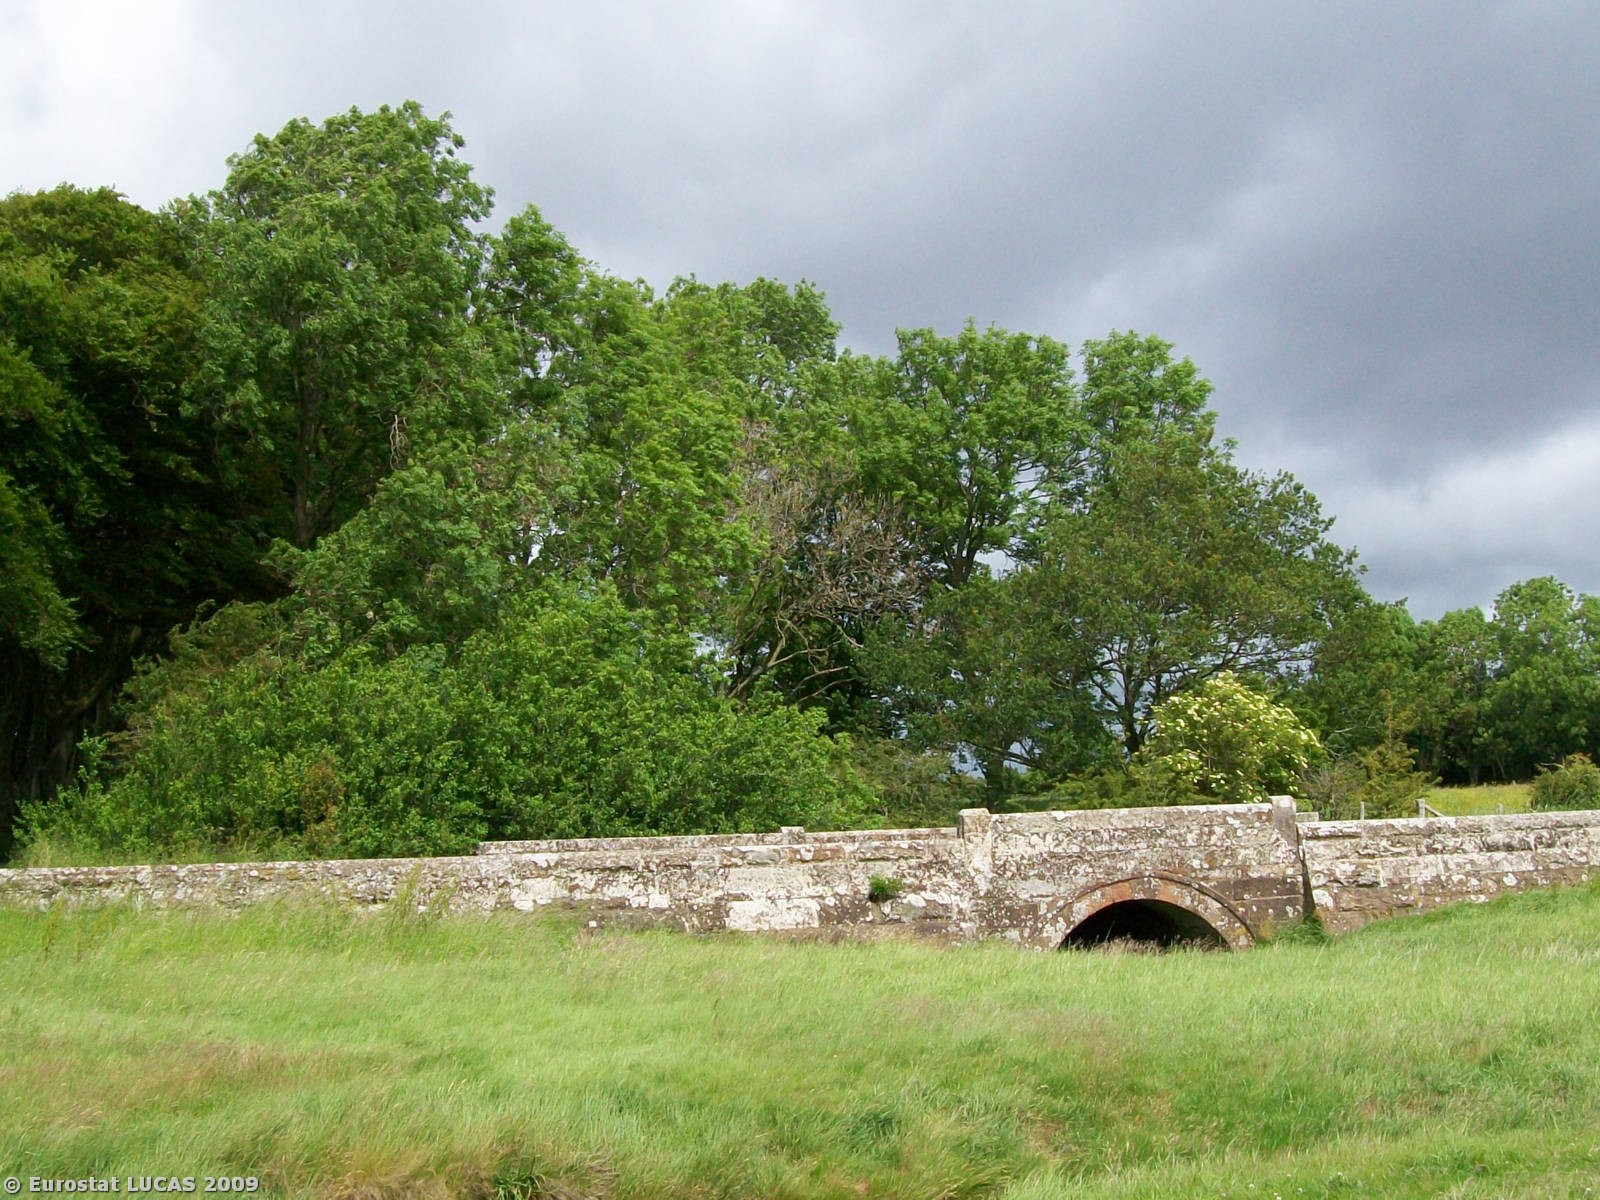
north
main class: Wetlands
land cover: Salt marshes
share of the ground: > 75 %
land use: Unused
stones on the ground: < 10 %
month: June
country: GB
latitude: 54.9120
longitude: -3.2572
